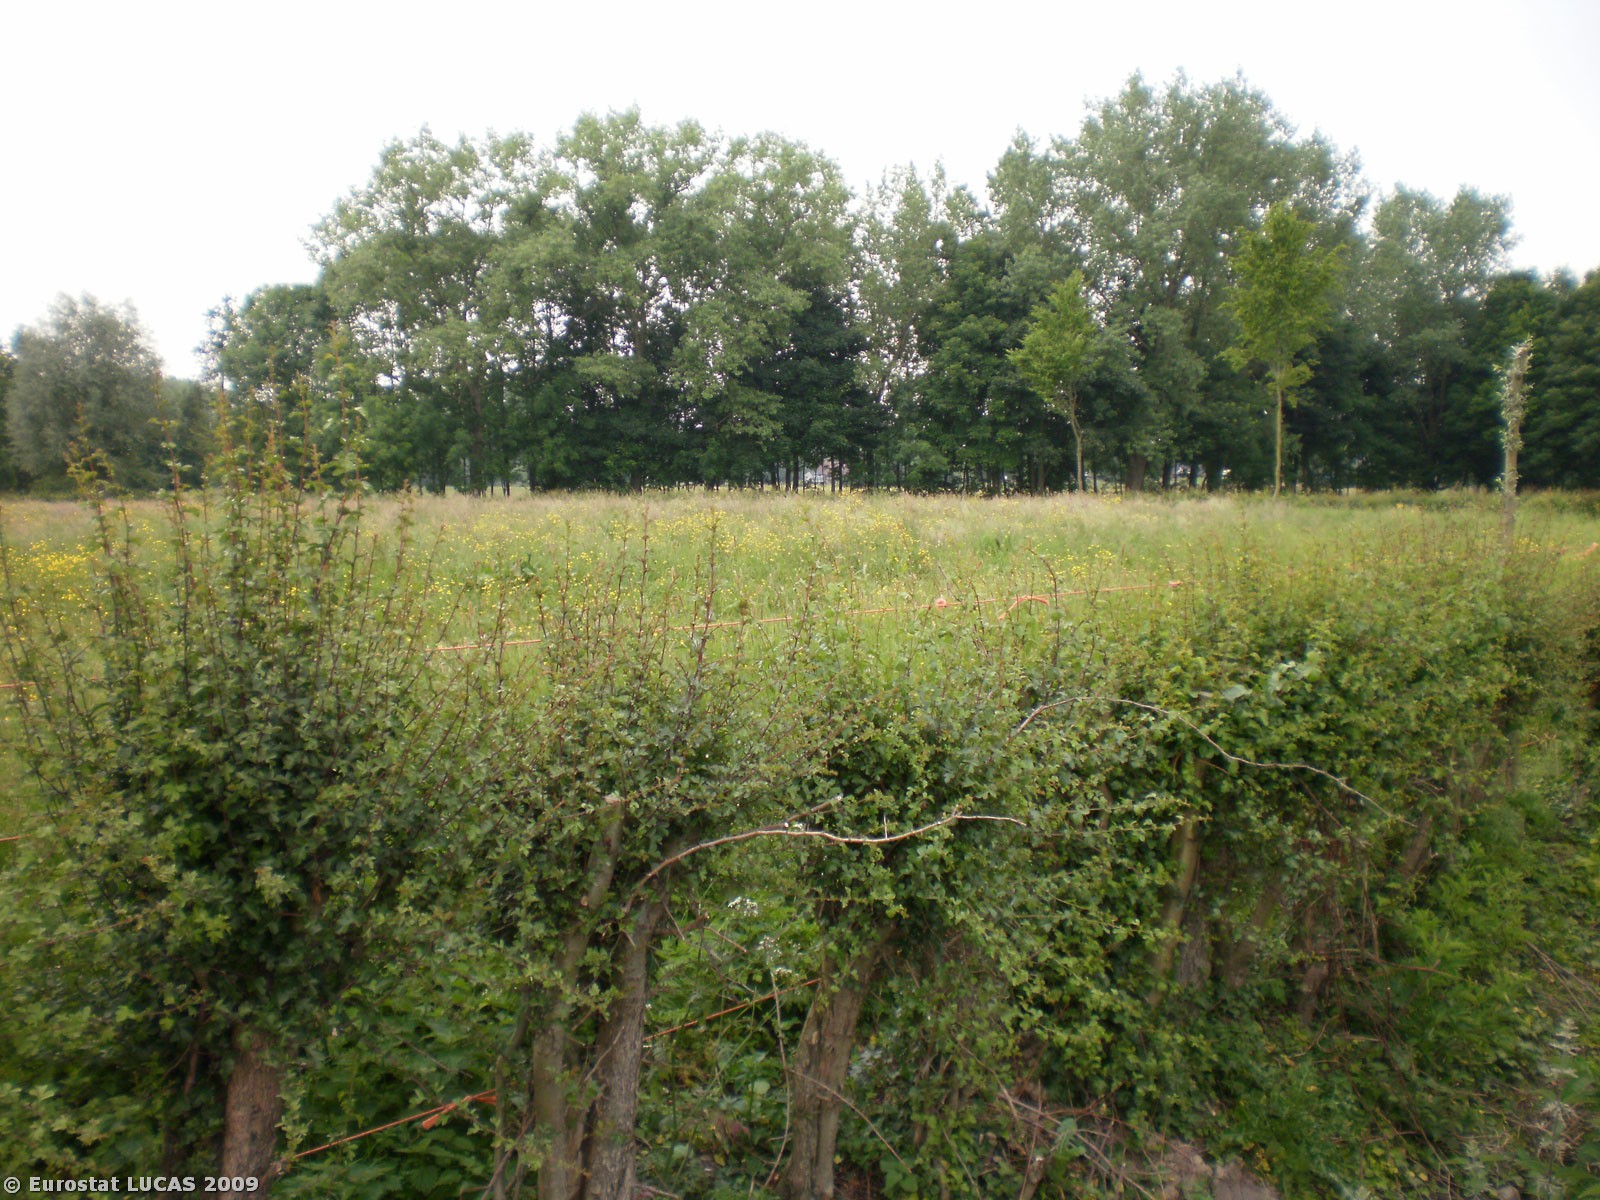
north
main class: Grassland
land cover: Grassland without tree/shrub cover
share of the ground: > 75 %
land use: Agriculture (excluding fallow land and kitchen gardens)
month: May
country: BE
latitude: 50.6653
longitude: 3.8108
